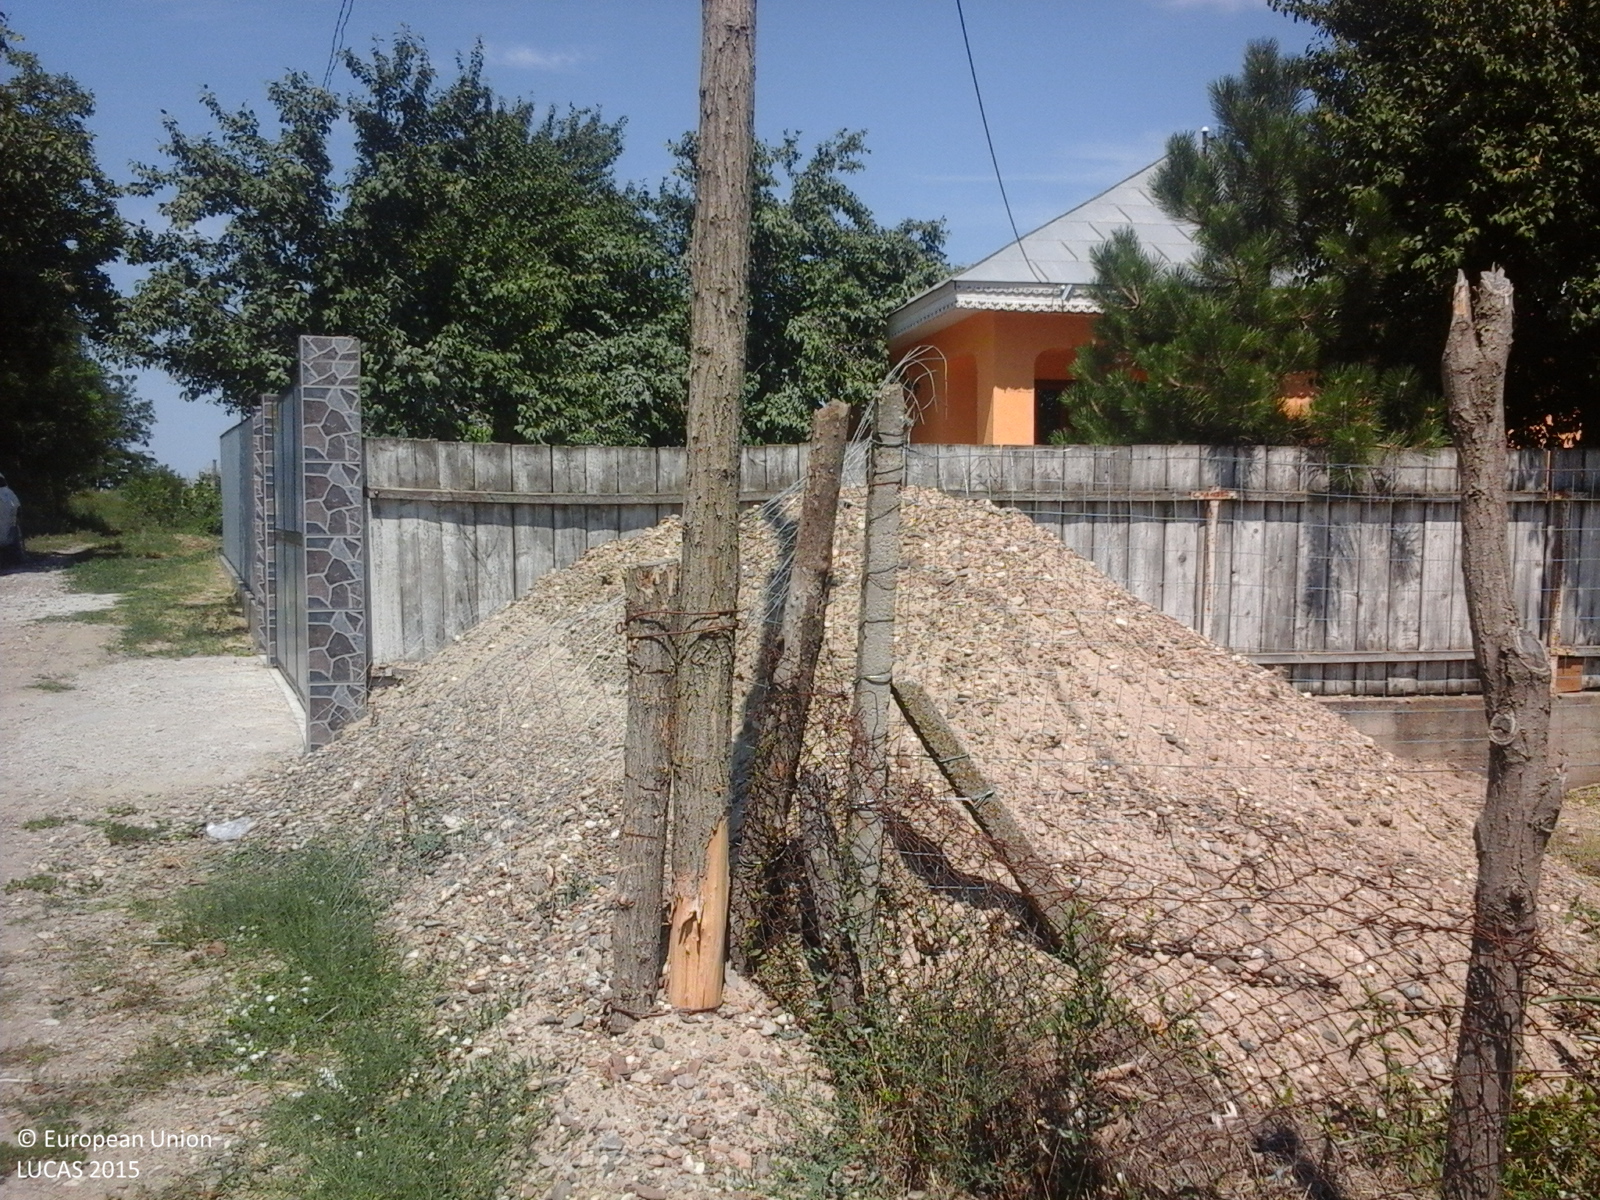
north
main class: Cropland
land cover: Maize
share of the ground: > 75 %
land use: Agriculture (excluding fallow land and kitchen gardens)
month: August
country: RO
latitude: 45.7636
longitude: 27.4748
